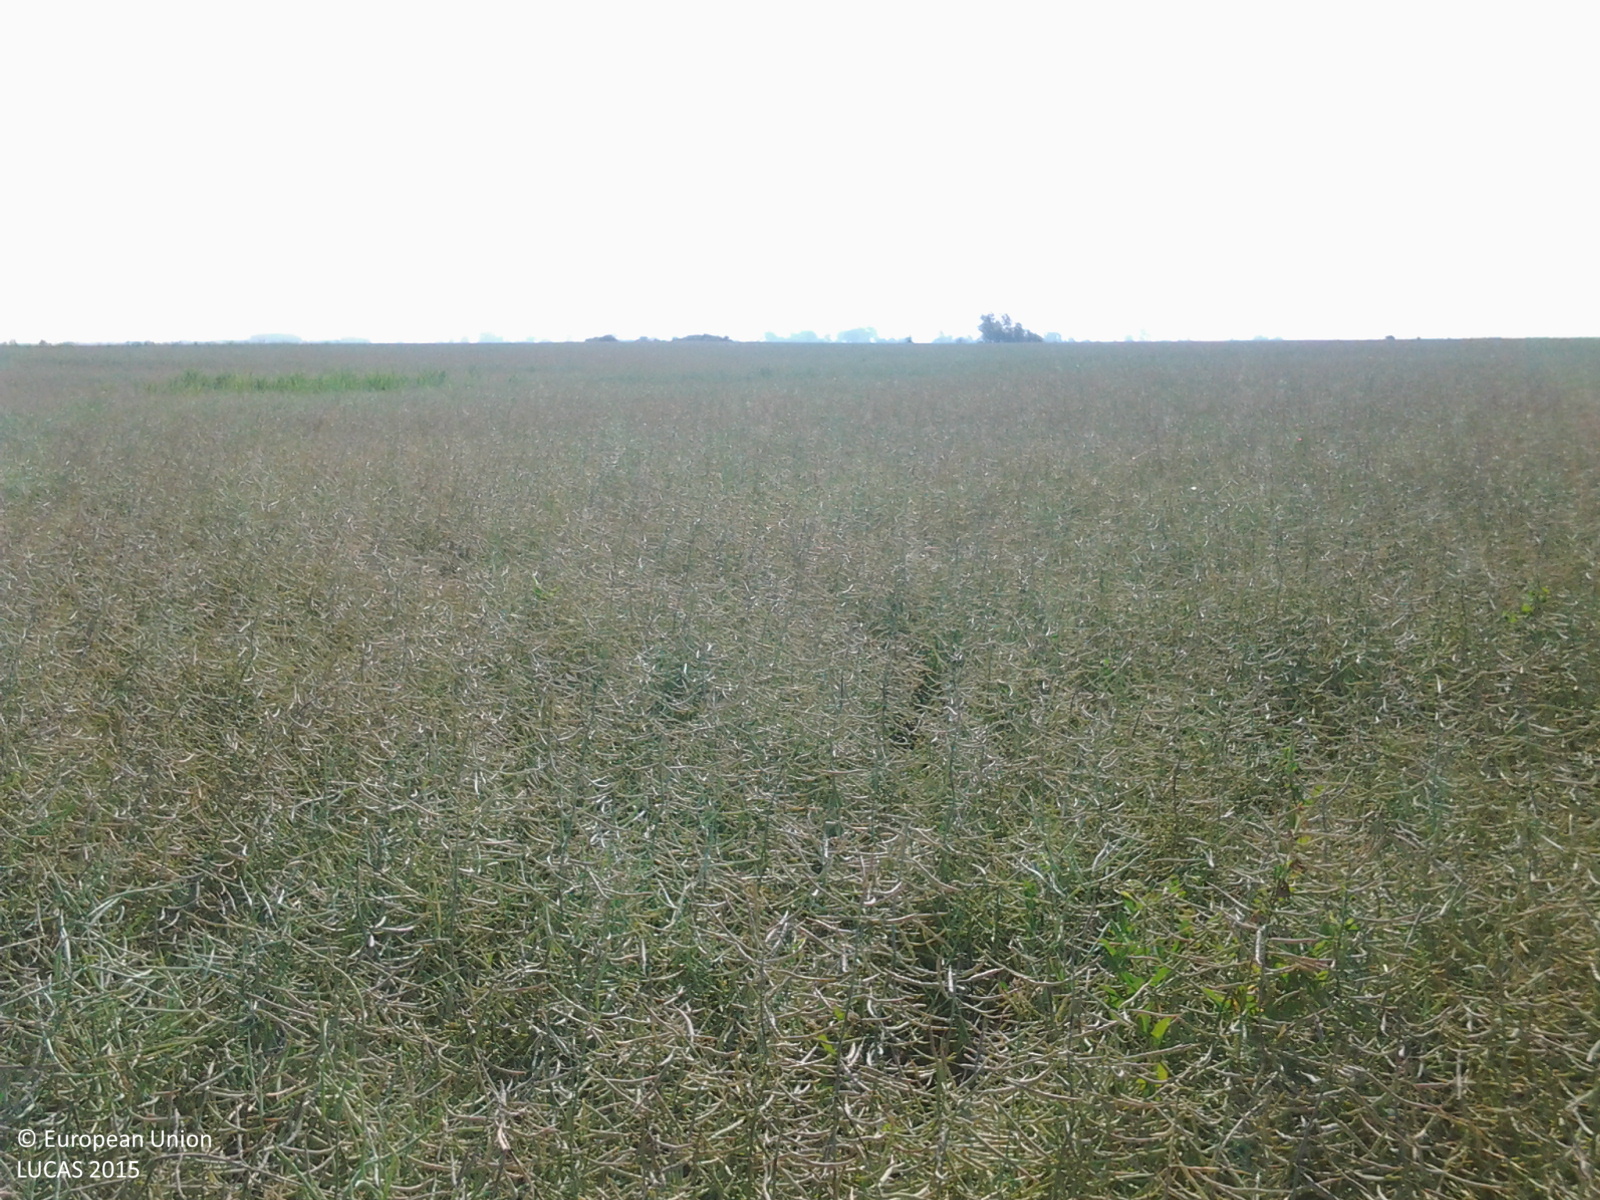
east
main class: Cropland
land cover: Rape and turnip rape
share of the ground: > 75 %
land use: Agriculture (excluding fallow land and kitchen gardens)
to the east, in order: Rape and turnip rape
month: June
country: HU
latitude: 46.5931
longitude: 18.9284
